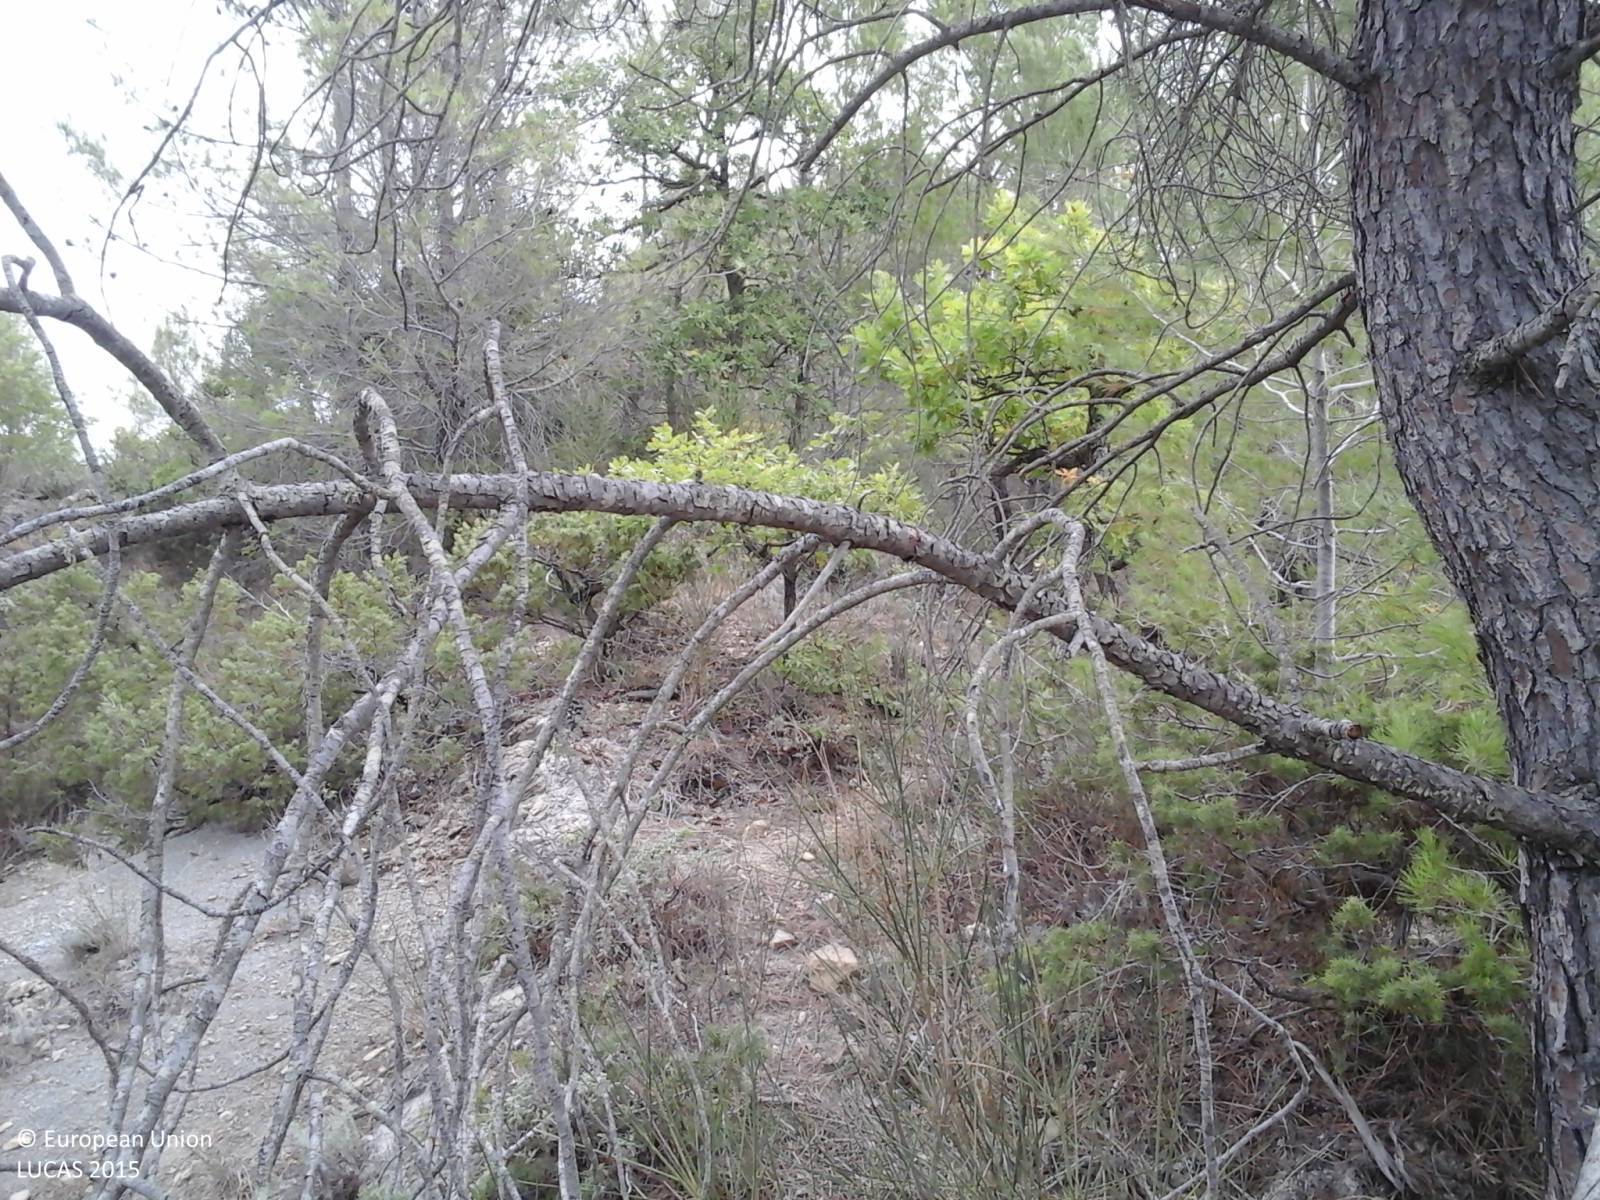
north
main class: Woodland
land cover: Broadleaved woodland
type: thermophilous deciduous forest
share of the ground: > 75 %
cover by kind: broadleaved forest trees 100 %
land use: Forestry
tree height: > 5 m
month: September
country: IT
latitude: 42.9179
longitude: 12.2594
